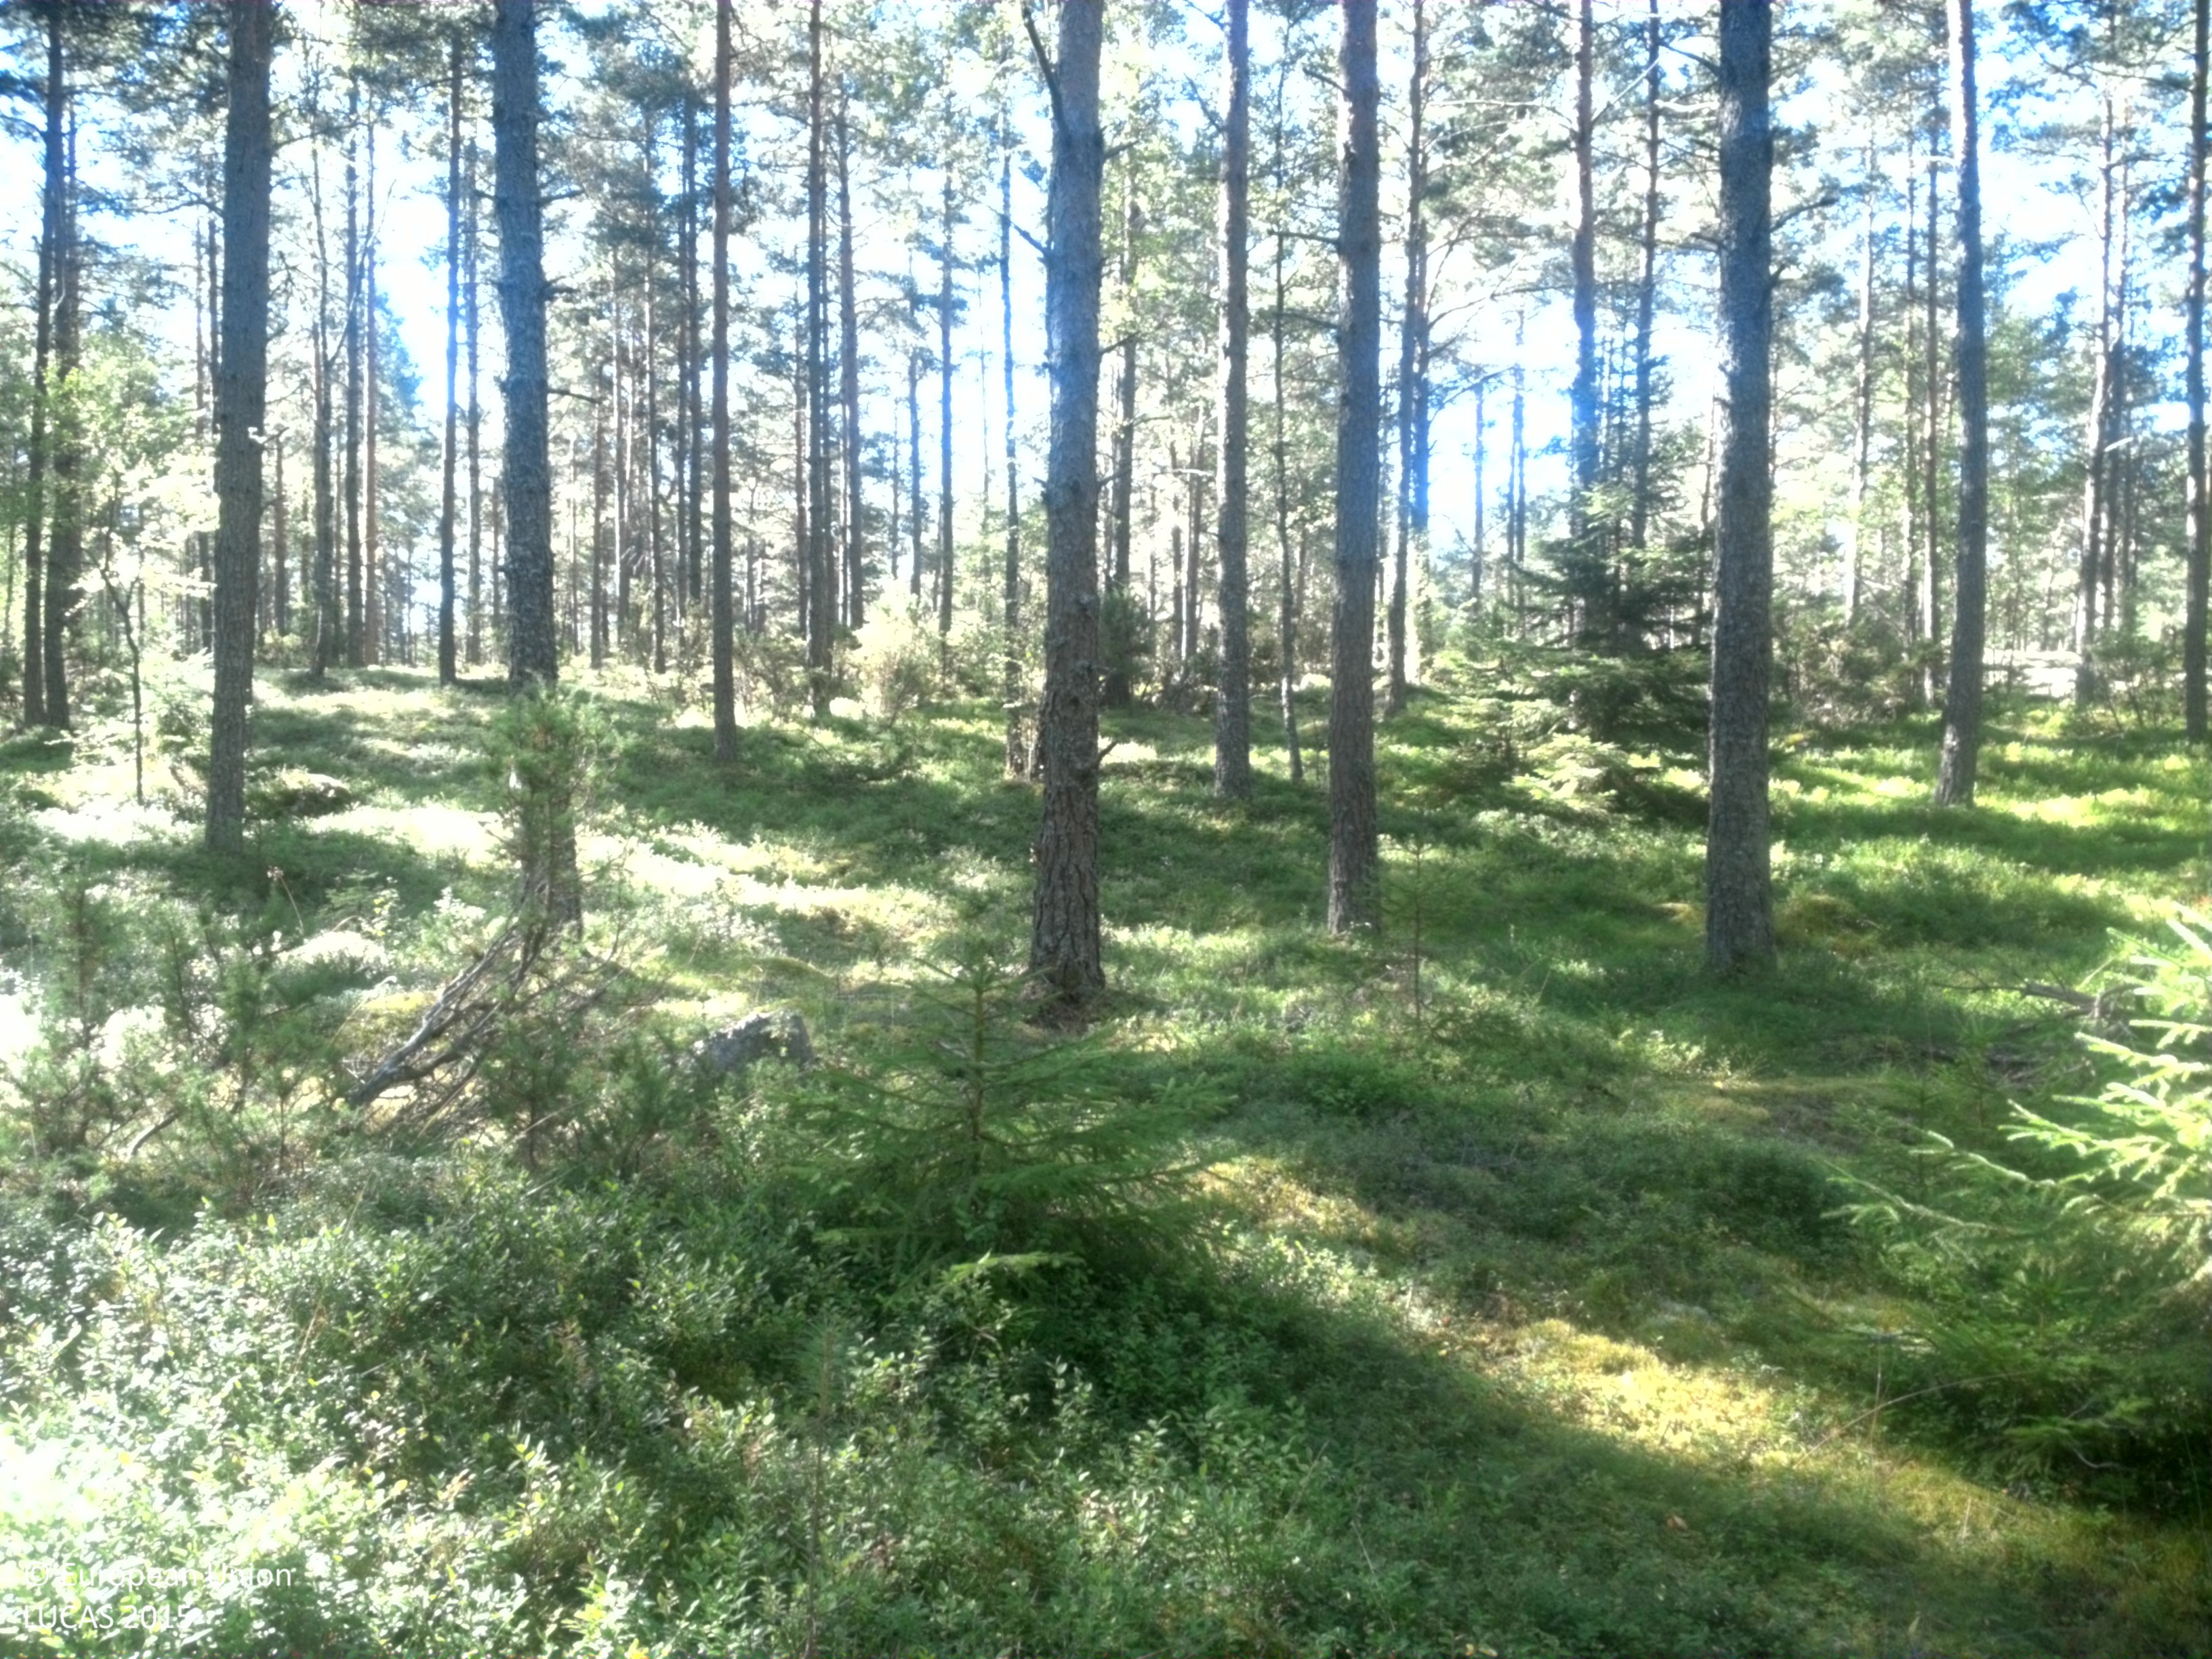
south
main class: Woodland
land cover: Pine dominated coniferous woodland
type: boreal forest
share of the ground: 50 - 75 %
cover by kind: coniferous forest trees 70 %, shrubs 25 %, lichens and mosses 5 %
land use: Forestry
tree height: > 5 m
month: August
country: SE
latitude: 59.7651
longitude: 17.1325
